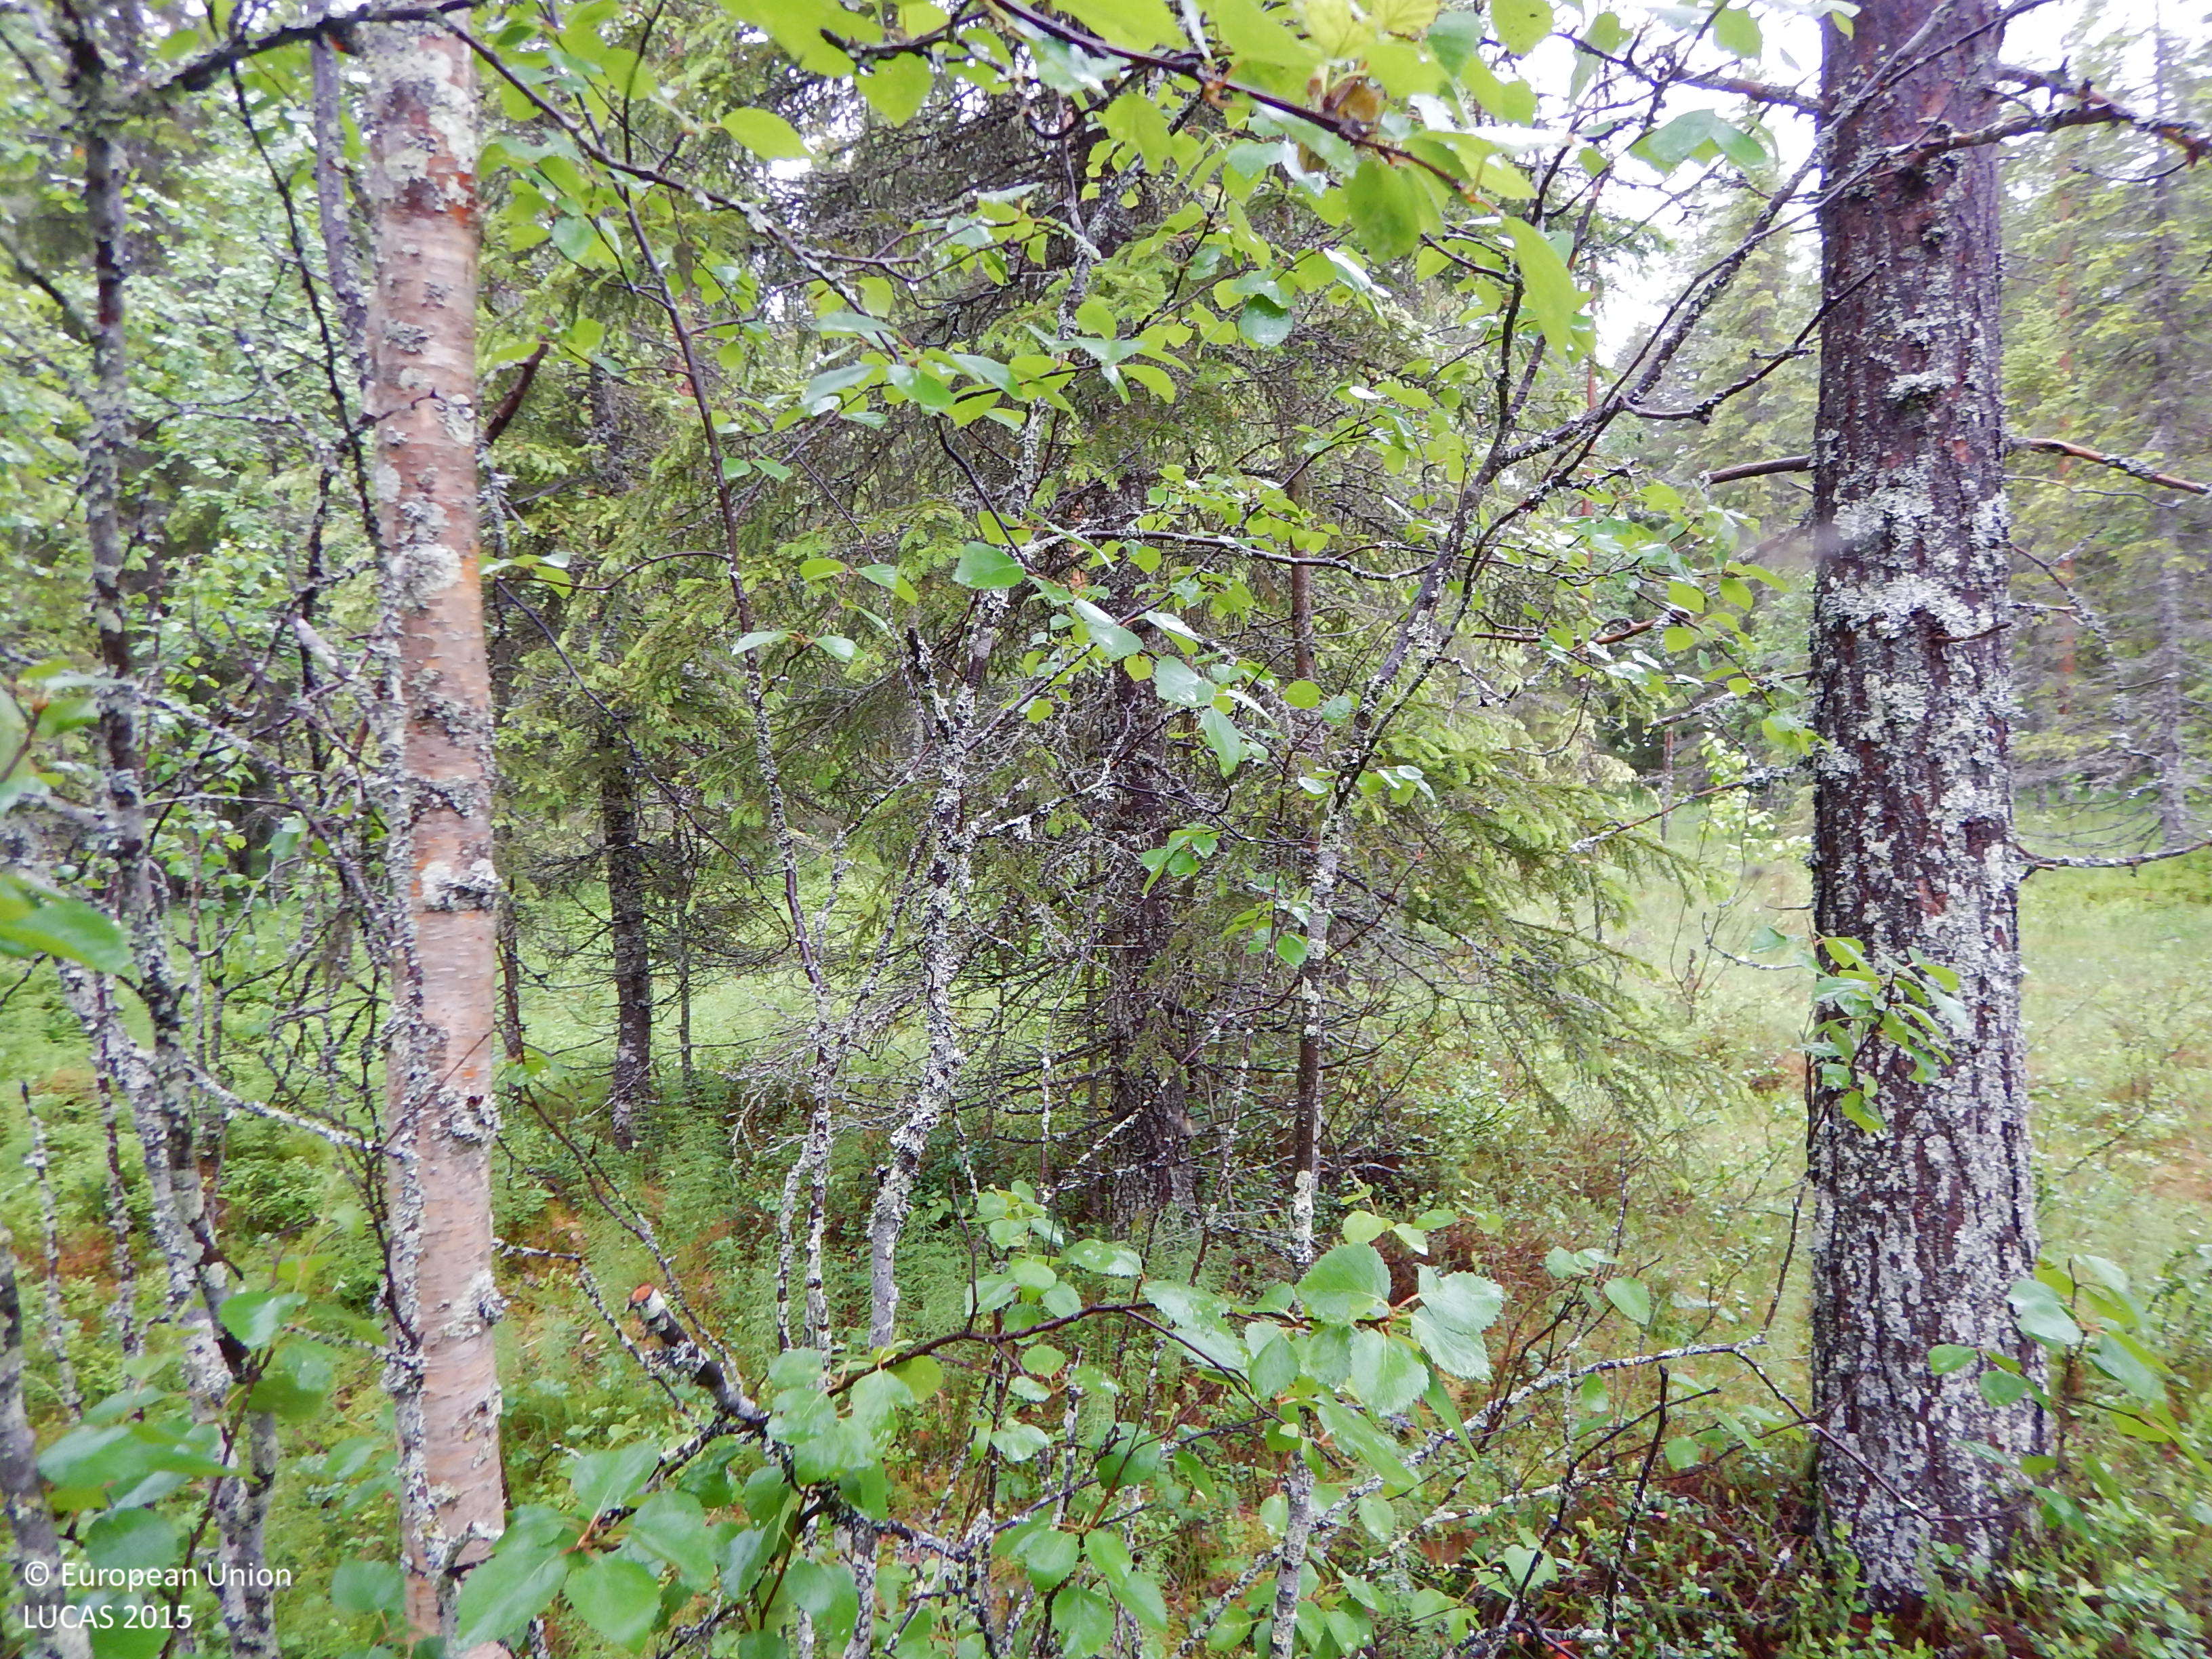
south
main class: Woodland
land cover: Other mixed woodland
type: boreal forest
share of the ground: 50 - 75 %
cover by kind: coniferous forest trees 40 %, herbaceous plants 20 %, lichens and mosses 20 %, broadleaved forest trees 15 %, shrubs 5 %
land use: Forestry
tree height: > 5 m
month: September
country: SE
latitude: 65.0953
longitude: 18.8816
